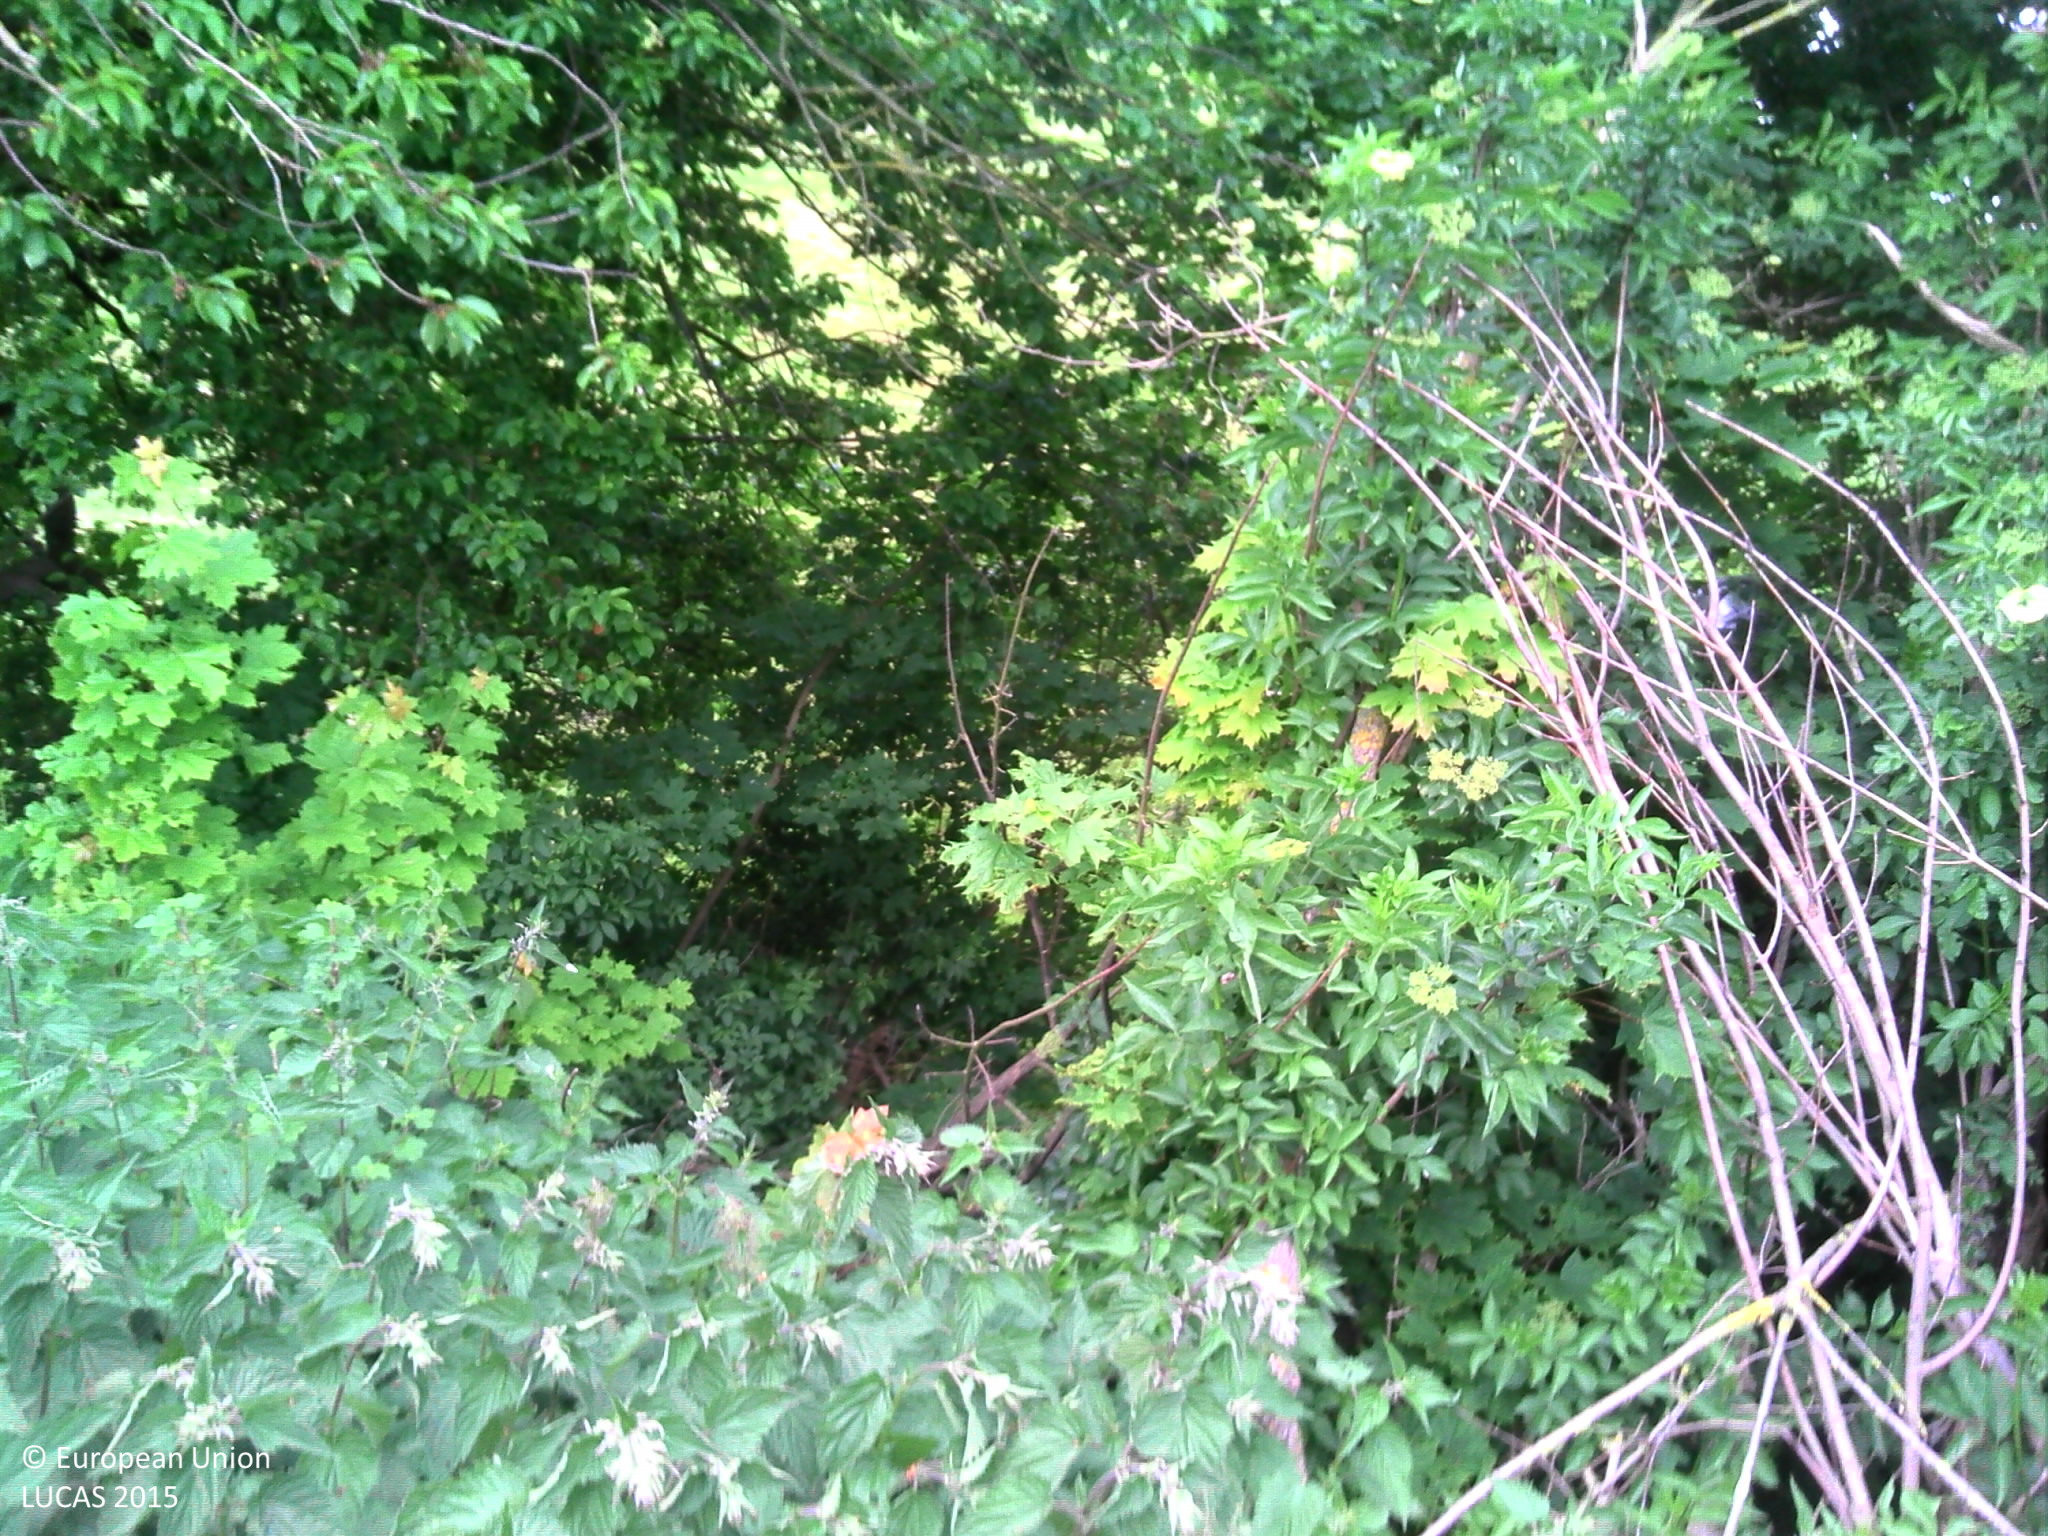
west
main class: Woodland
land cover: Broadleaved woodland
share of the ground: > 75 %
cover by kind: broadleaved forest trees 100 %
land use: Amenities, museums, leisure
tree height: > 5 m
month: May
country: BE
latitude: 50.6778
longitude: 4.4056
